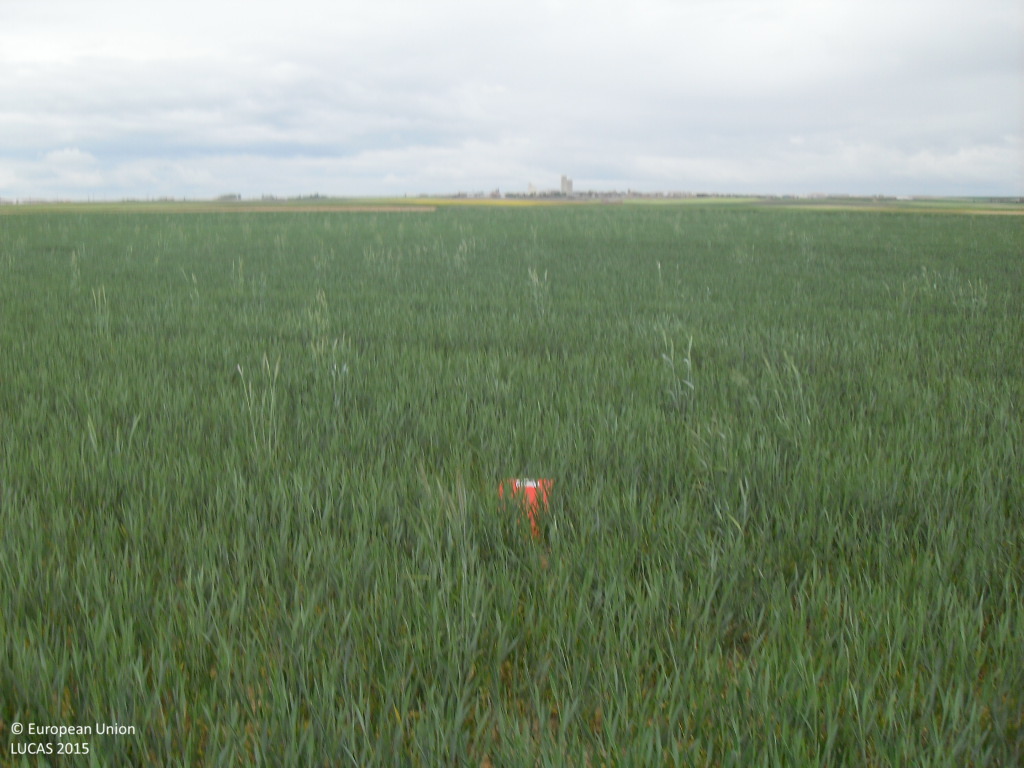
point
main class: Cropland
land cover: Common wheat
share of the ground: > 75 %
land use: Agriculture (excluding fallow land and kitchen gardens)
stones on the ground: 10 - 25 %
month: April
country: ES
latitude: 40.8861
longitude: -5.2475
